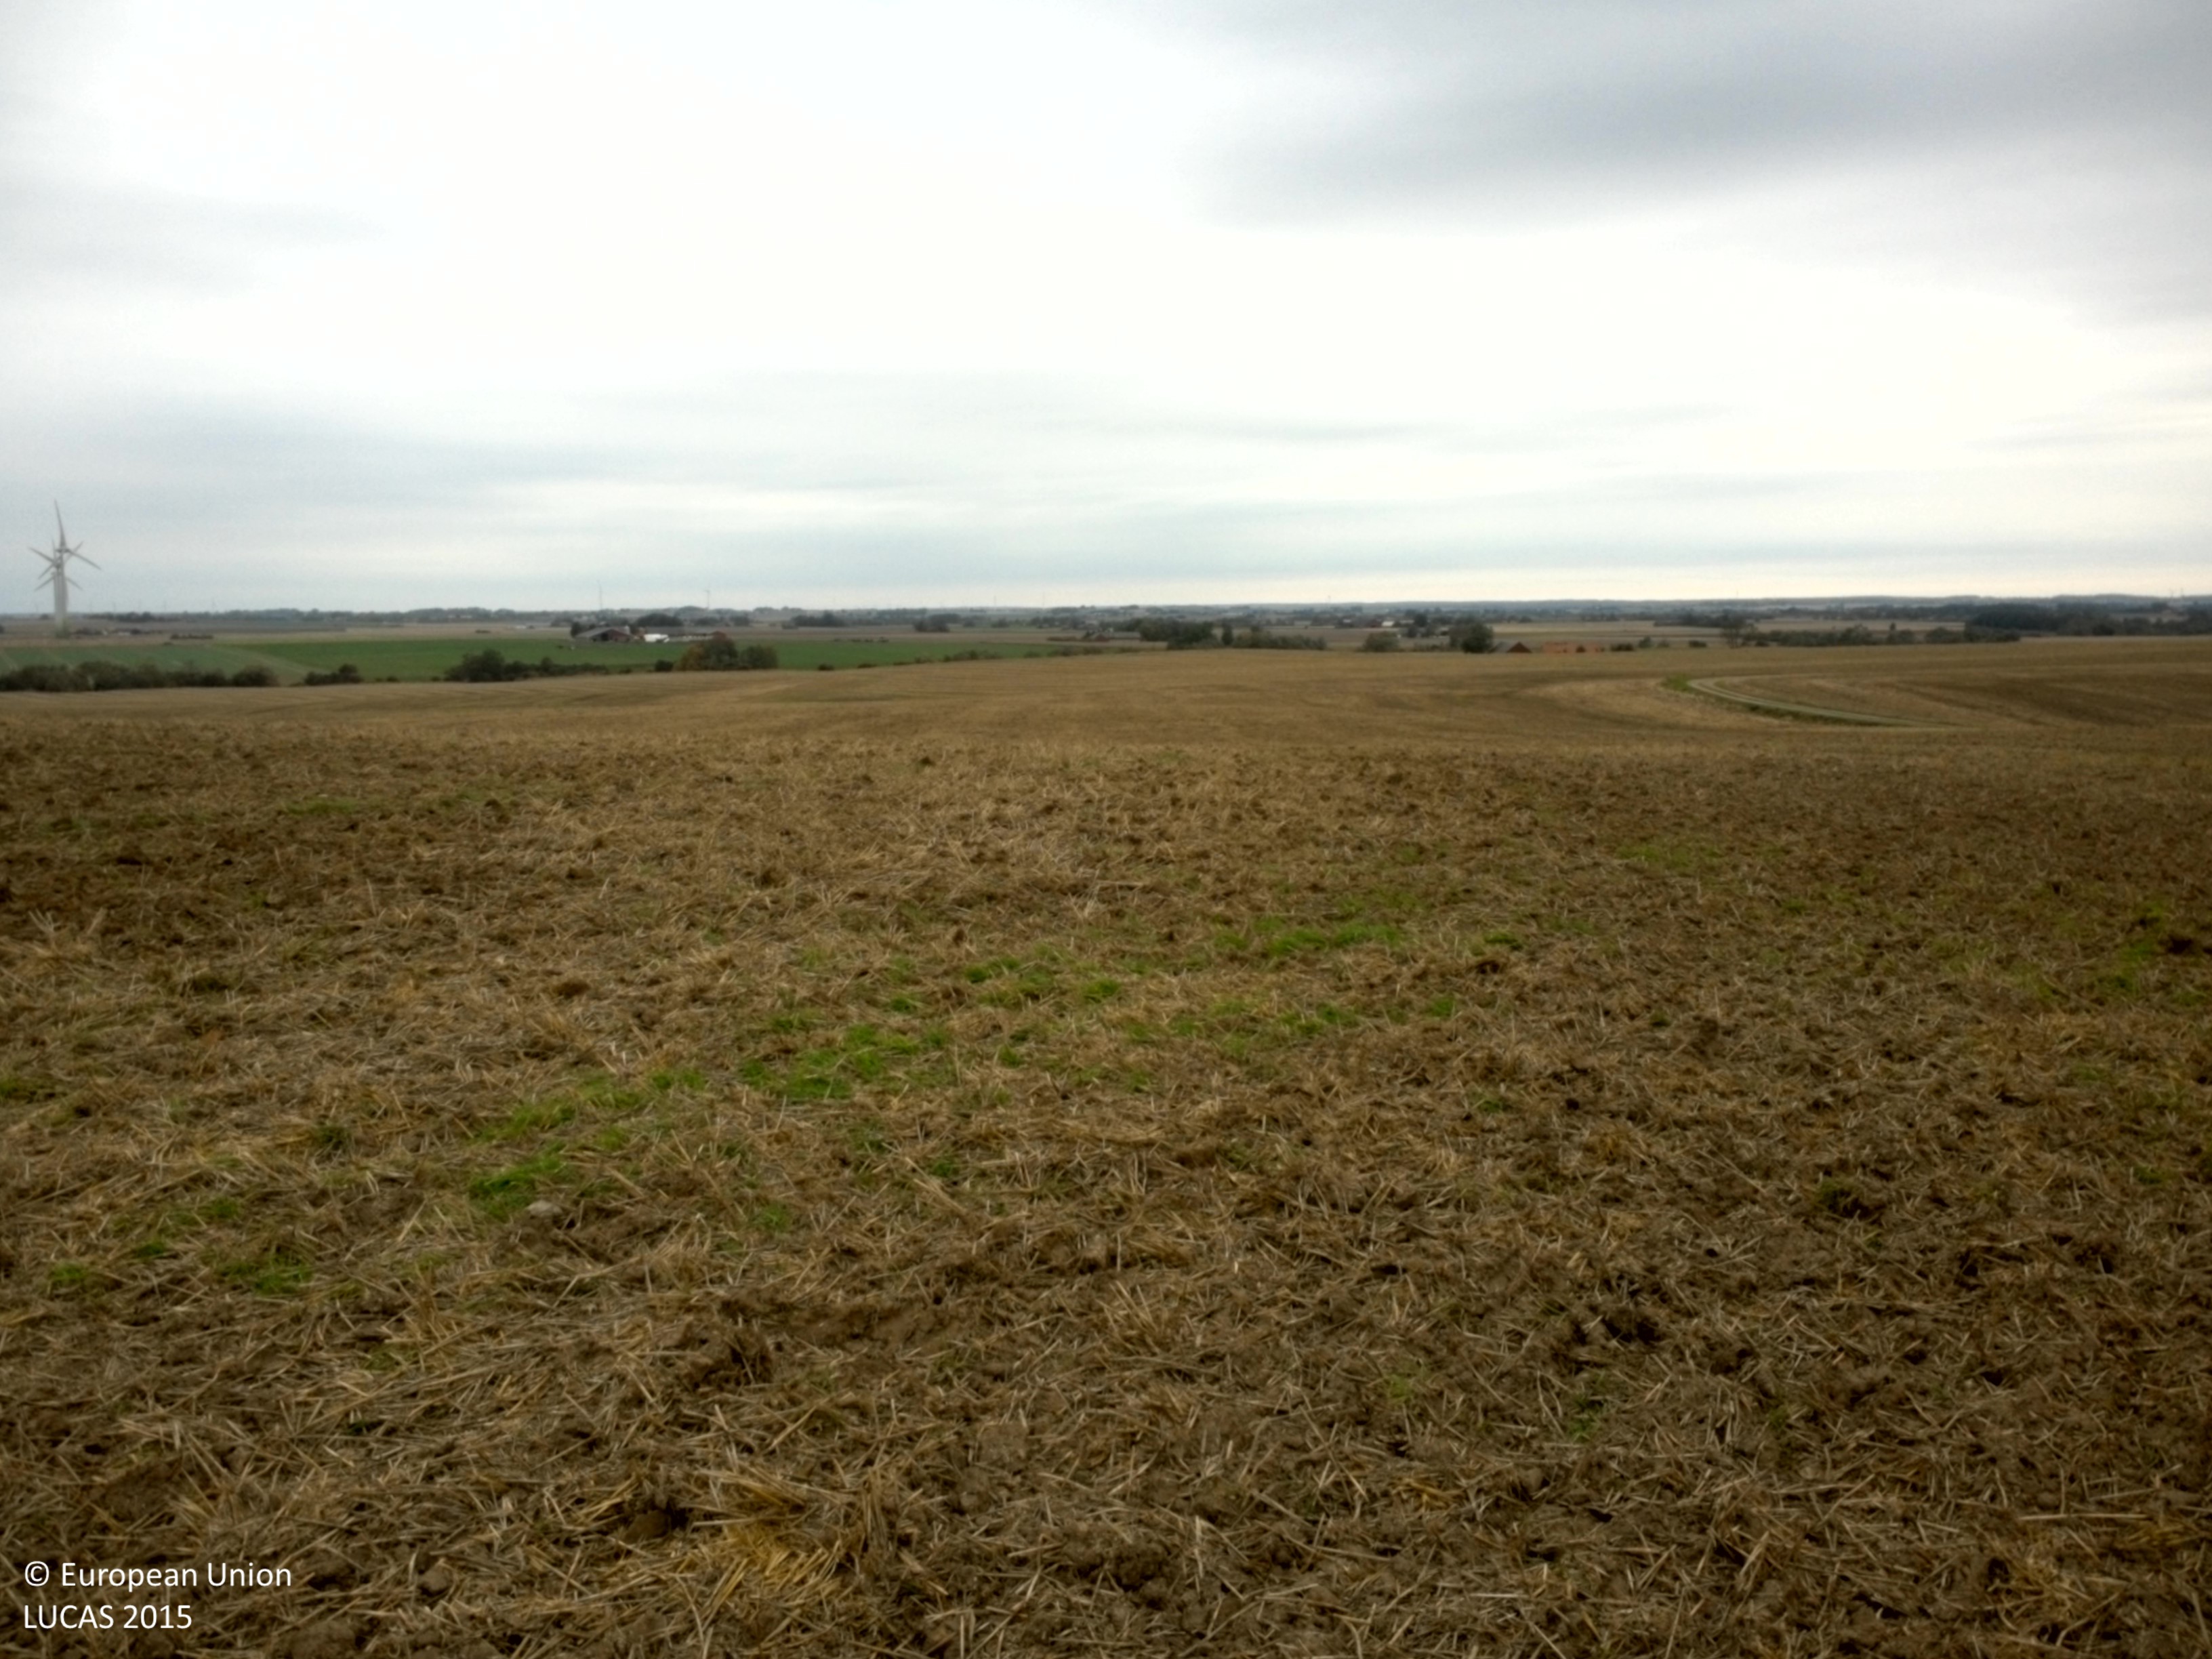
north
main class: Cropland
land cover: Common wheat
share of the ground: < 10 %
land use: Agriculture (excluding fallow land and kitchen gardens)
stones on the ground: < 10 %
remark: Harvested field
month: October
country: SE
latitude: 55.8278
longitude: 13.0469
